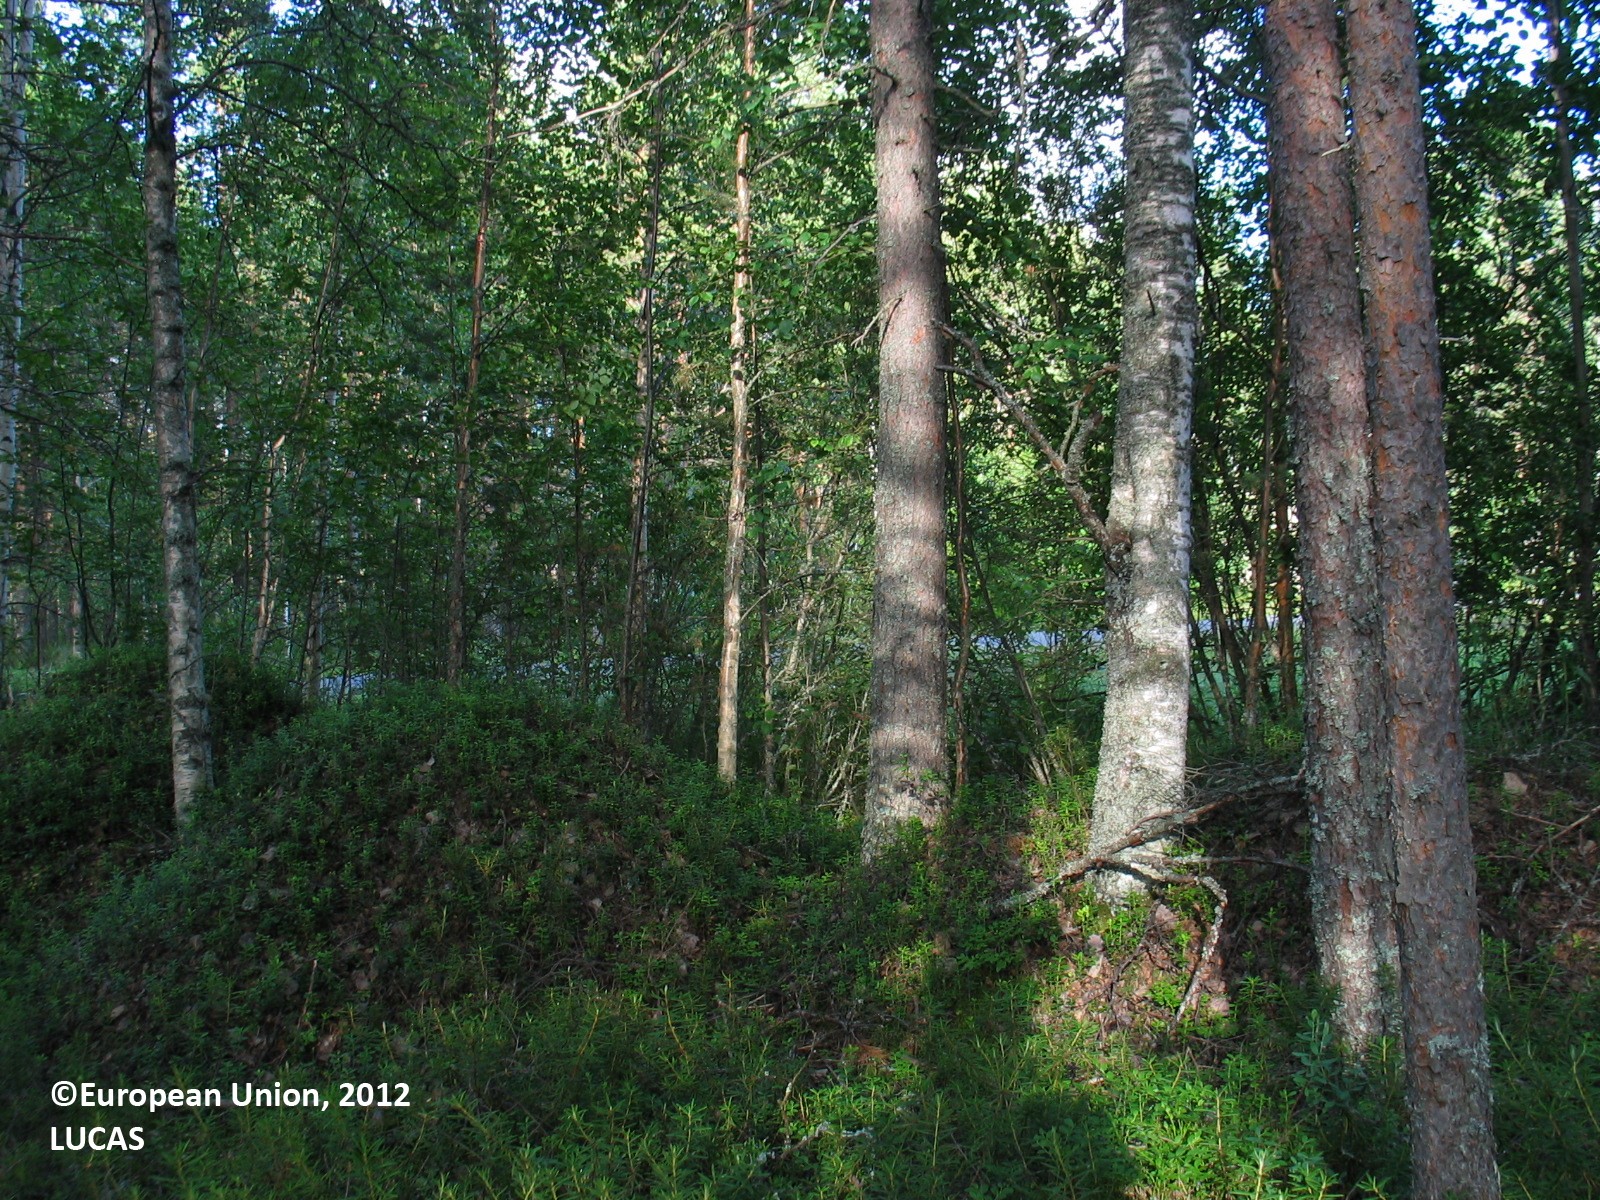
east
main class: Woodland
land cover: Pine dominated coniferous woodland
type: mire and swamp forests
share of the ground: 50 - 75 %
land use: Forestry
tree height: > 5 m
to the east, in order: Pine dominated coniferous woodland; Ditches and canals; Broadleaved woodland; Grass margins; Spontaneously vegetated surfaces; Grass margins; Ditches and canals; Grass margins; Paved roads, cycling and walking lanes; Grass margins; Ditches and canals; Electric lines; Groves; Shrubland without tree cover; Ditches and canals; Other mixed woodland; Artificial constructions in urban areas; Ditches and canals; Pine dominated coniferous woodland; Ditches and canals; Pine dominated coniferous woodland; Tracks; Pine dominated coniferous woodland
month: July
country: FI
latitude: 64.6559
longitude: 26.5070
